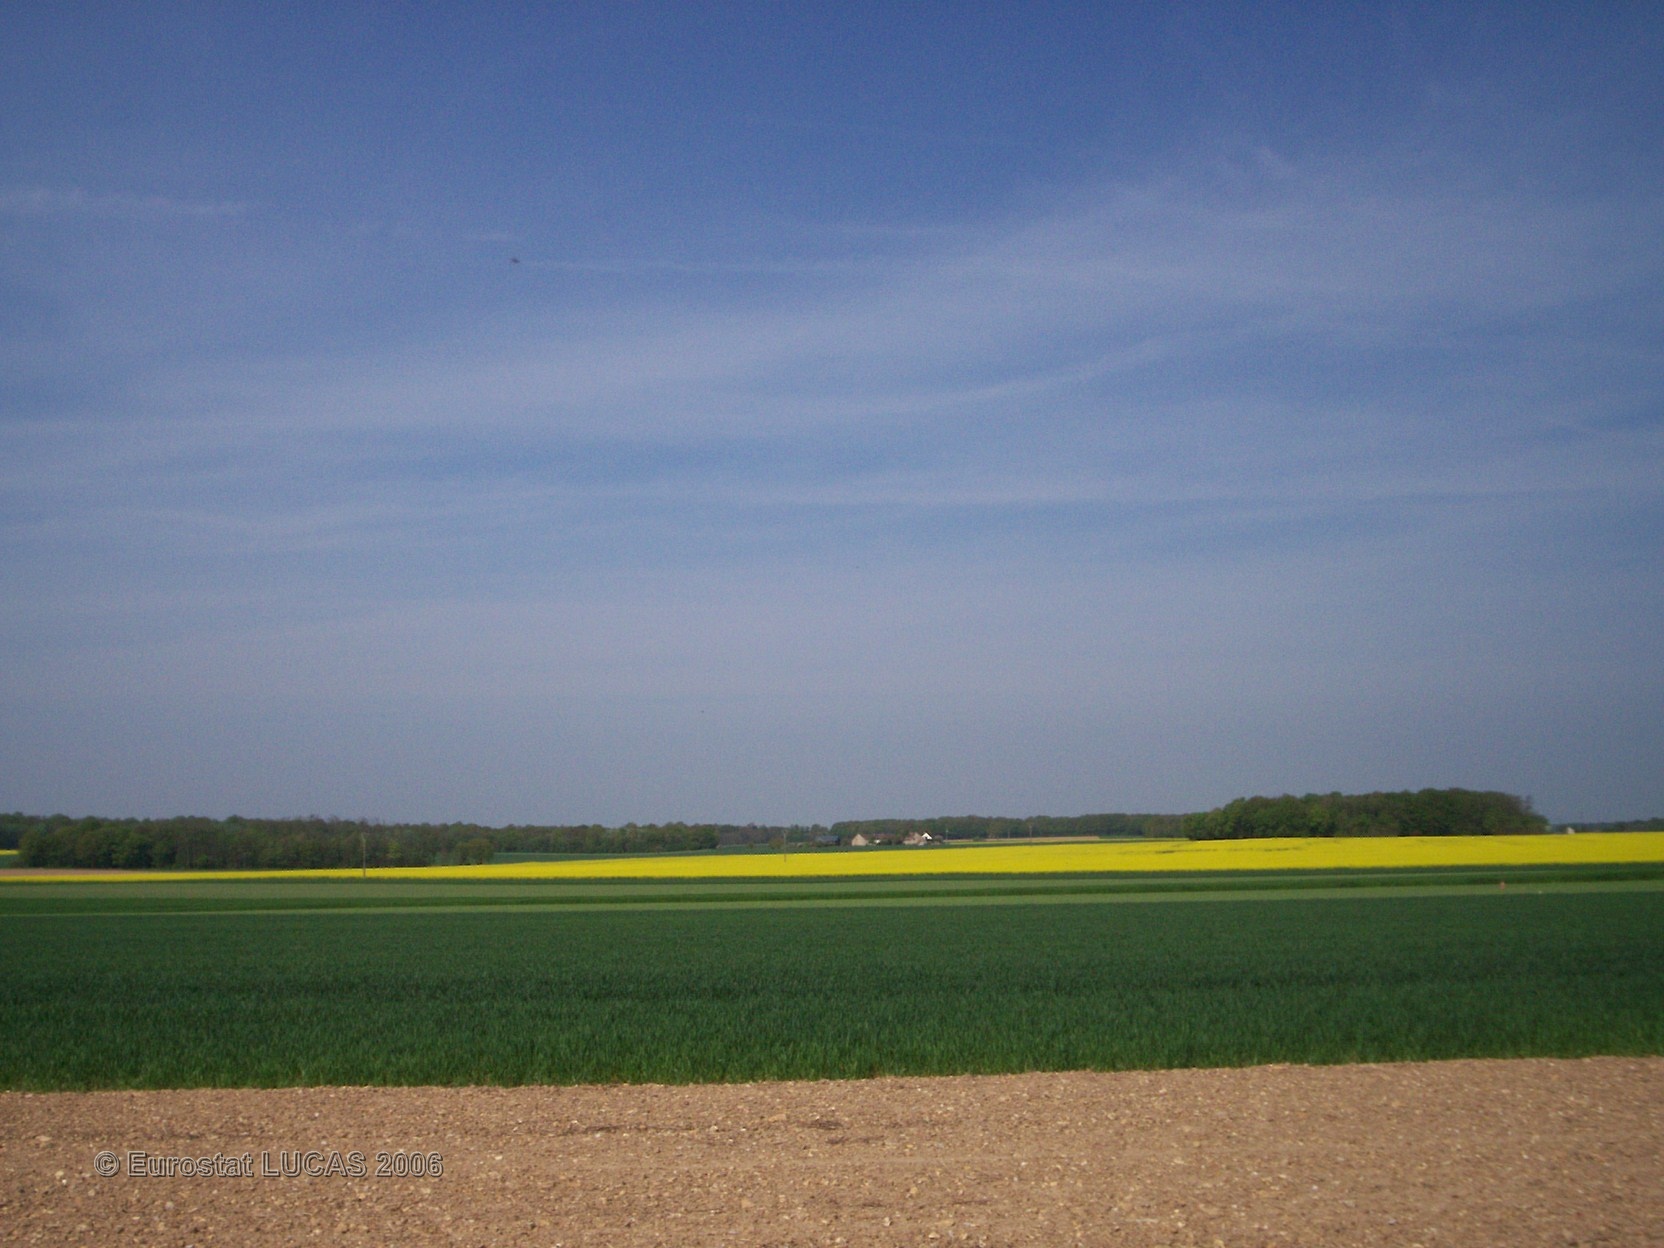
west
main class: Cropland
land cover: Sunflower
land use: Agriculture (excluding fallow land and kitchen gardens)
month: May
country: FR
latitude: 48.0502
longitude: 2.9225
